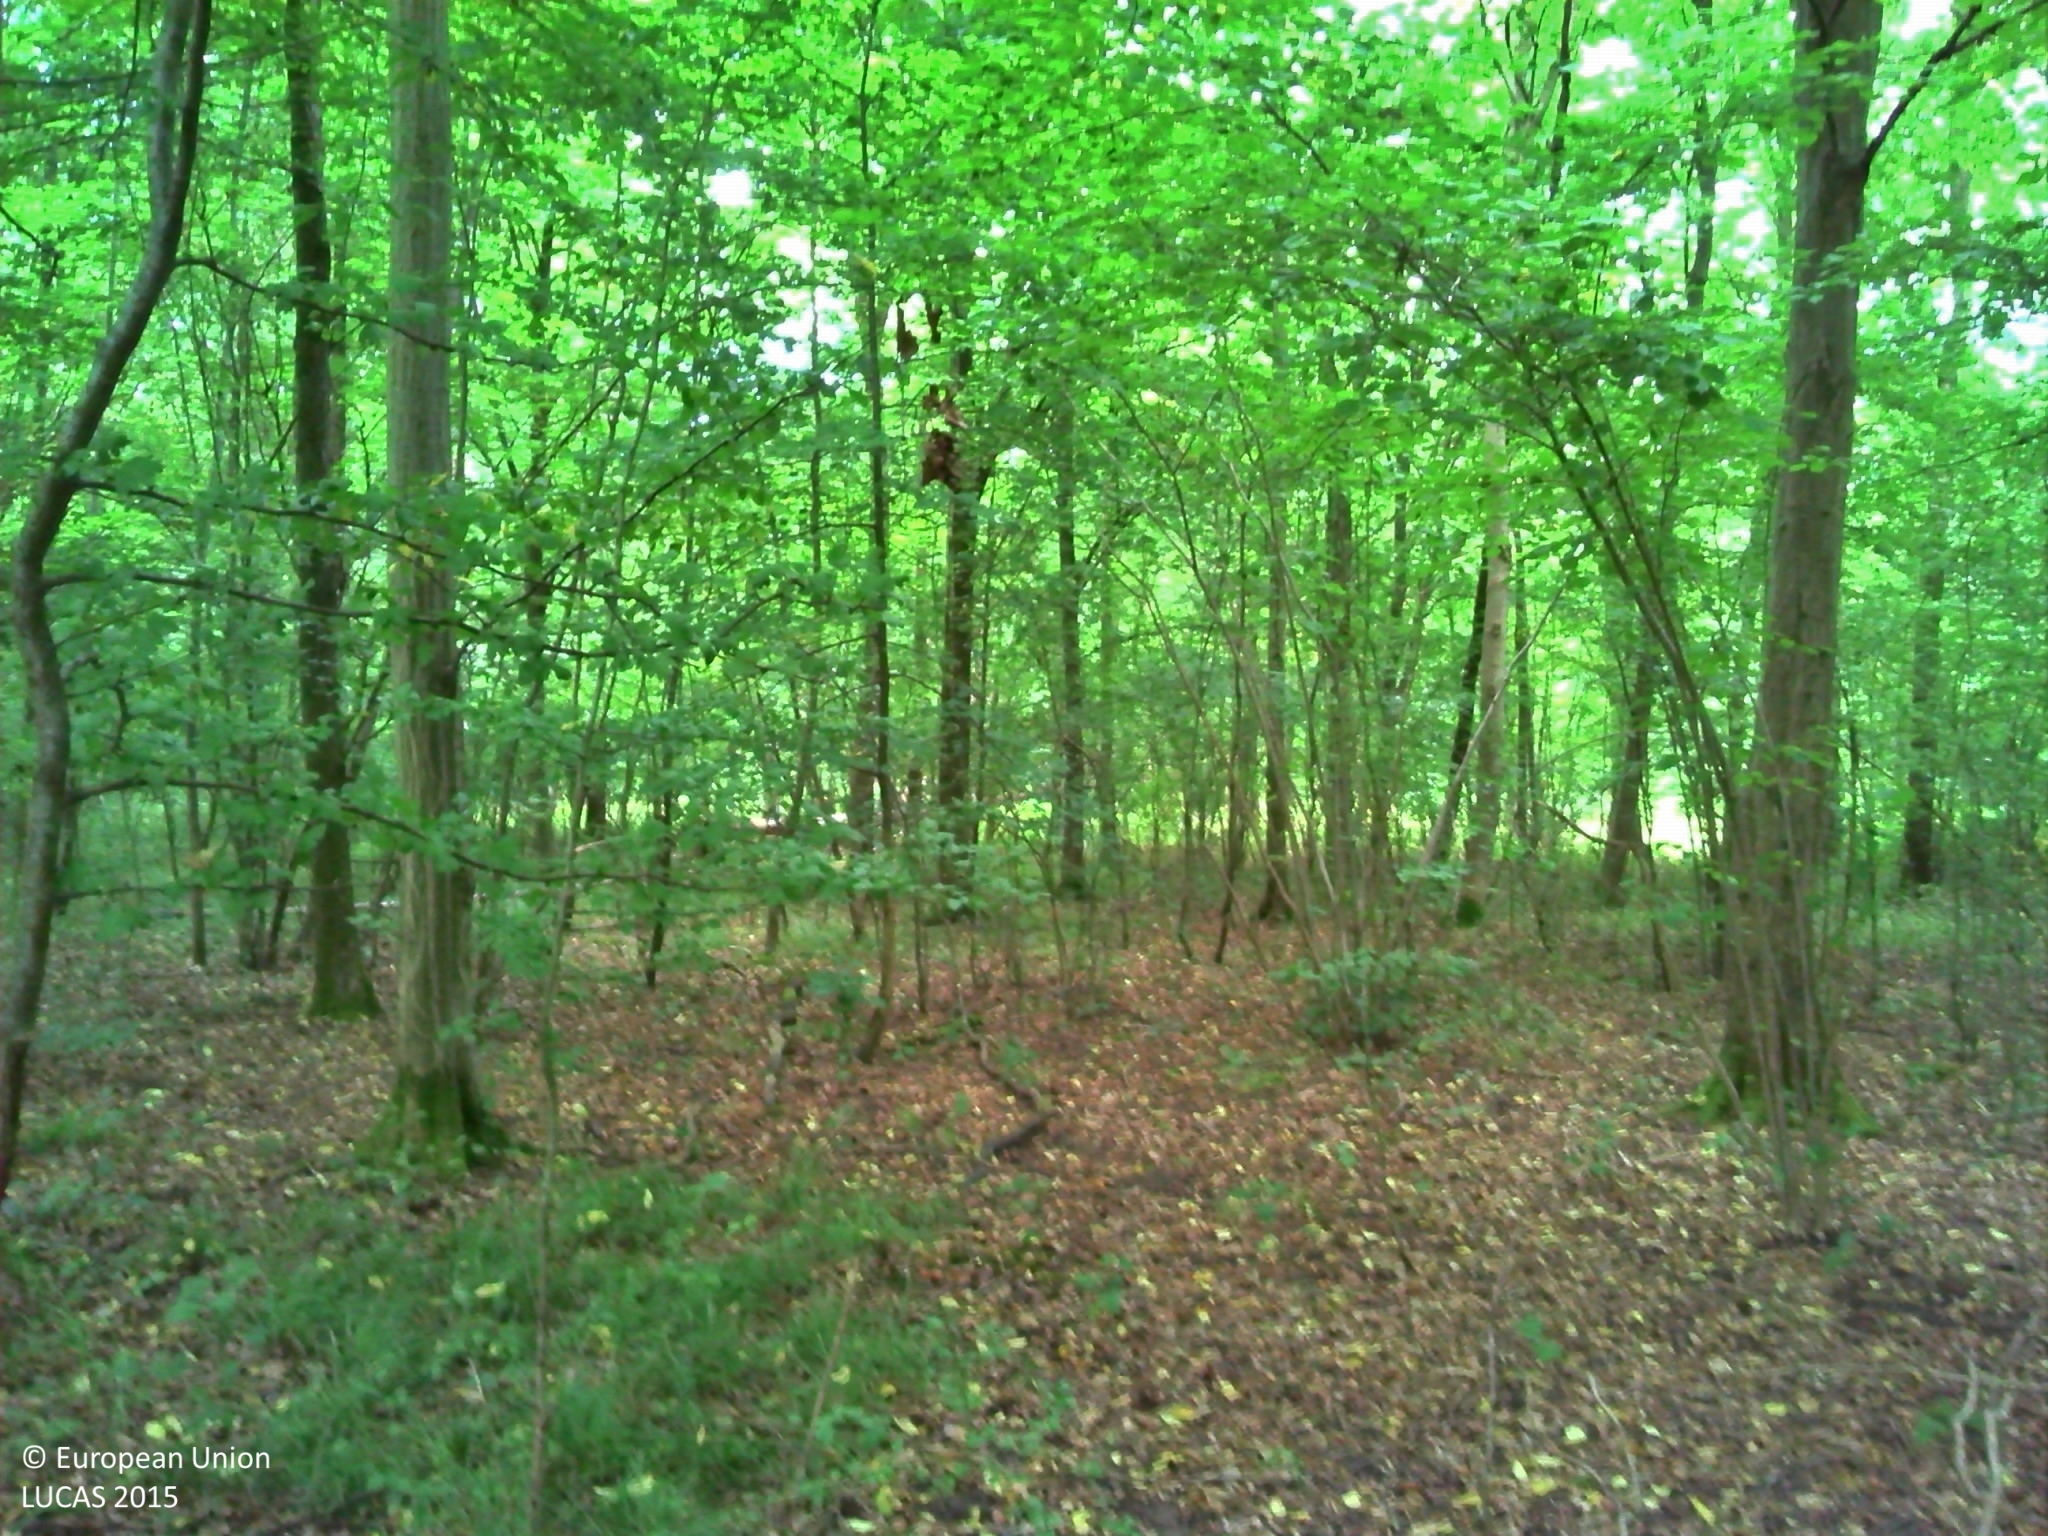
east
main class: Woodland
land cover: Broadleaved woodland
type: acidophilous oak and oak-birch forest
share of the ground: > 75 %
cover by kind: broadleaved forest trees 85 %, herbaceous plants 10 %, unconsolidated bare surface 5 %
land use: Forestry
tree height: > 5 m
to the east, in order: Broadleaved woodland; Tracks; Broadleaved woodland
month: July
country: FR
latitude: 49.1847
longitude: 2.5939
